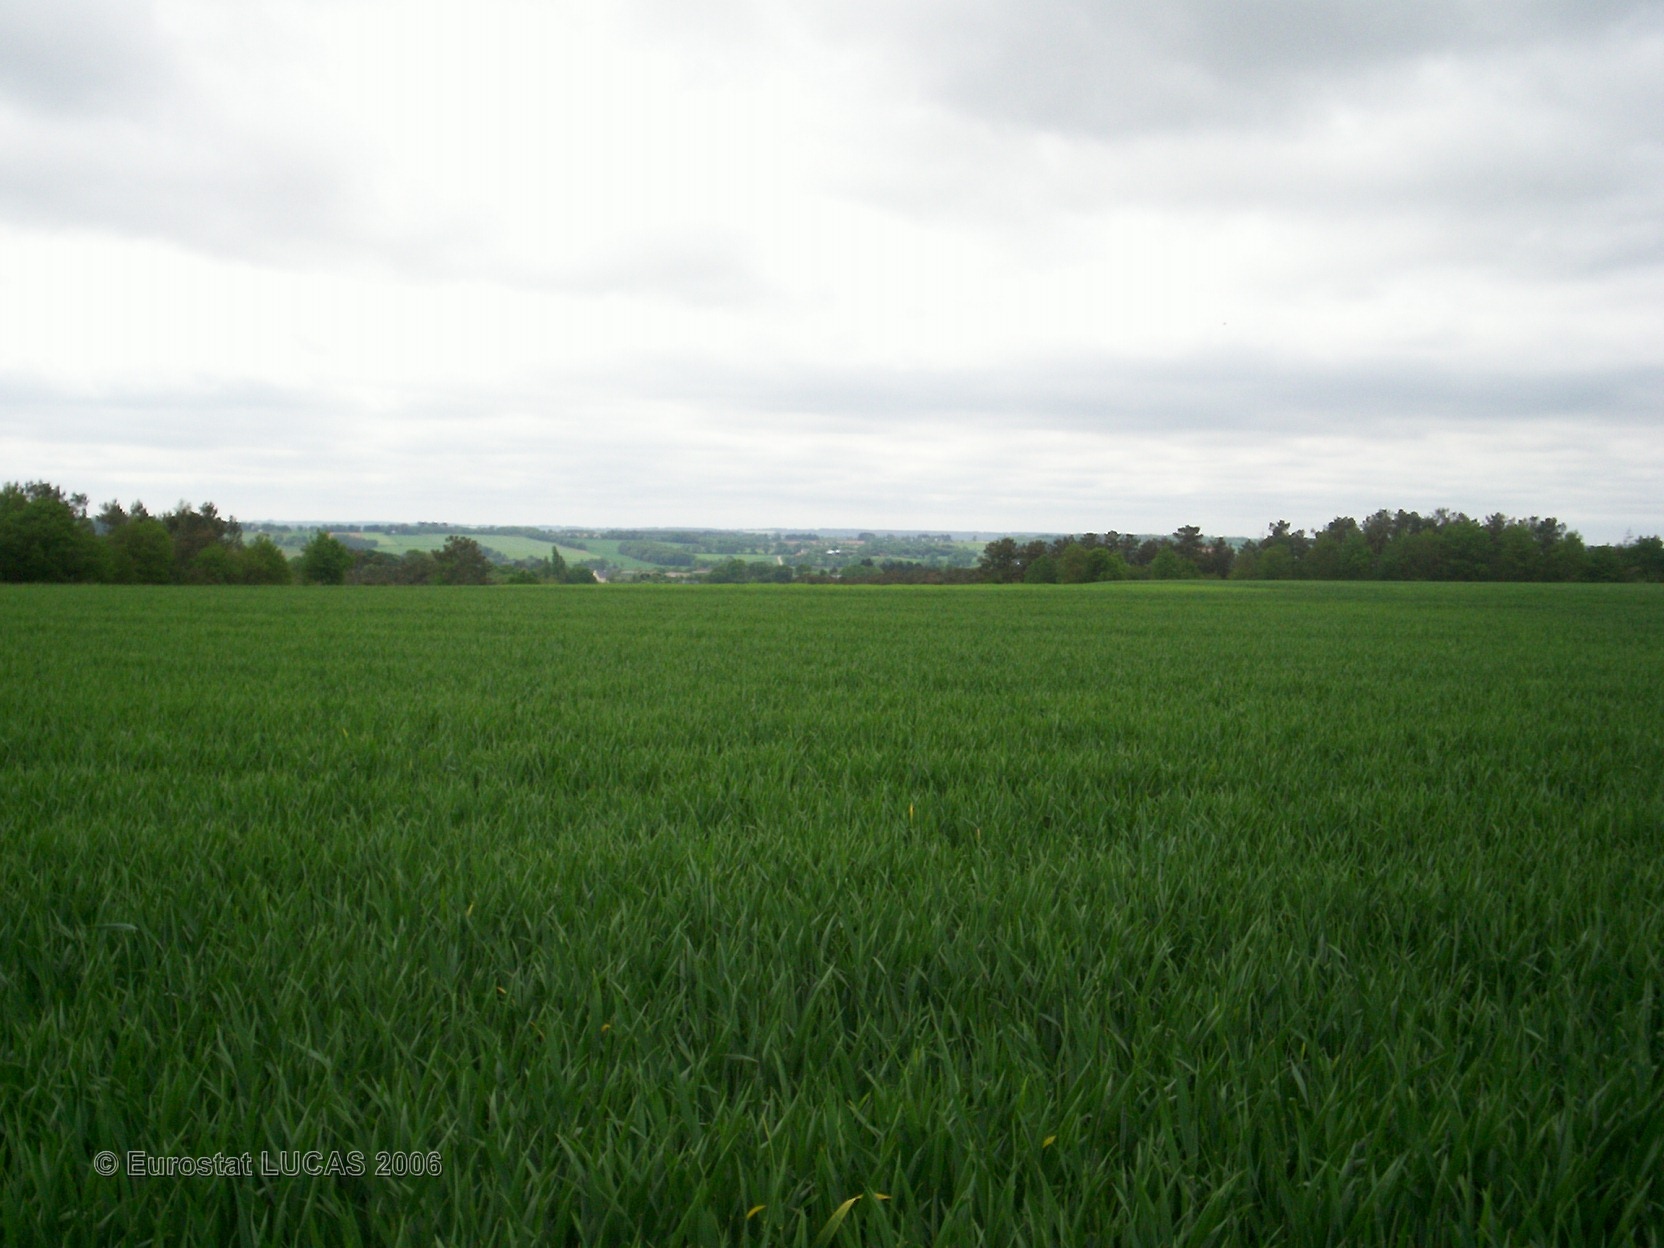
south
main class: Cropland
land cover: Common wheat
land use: Agriculture (excluding fallow land and kitchen gardens)
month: May
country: FR
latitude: 47.8815
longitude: -2.2641
